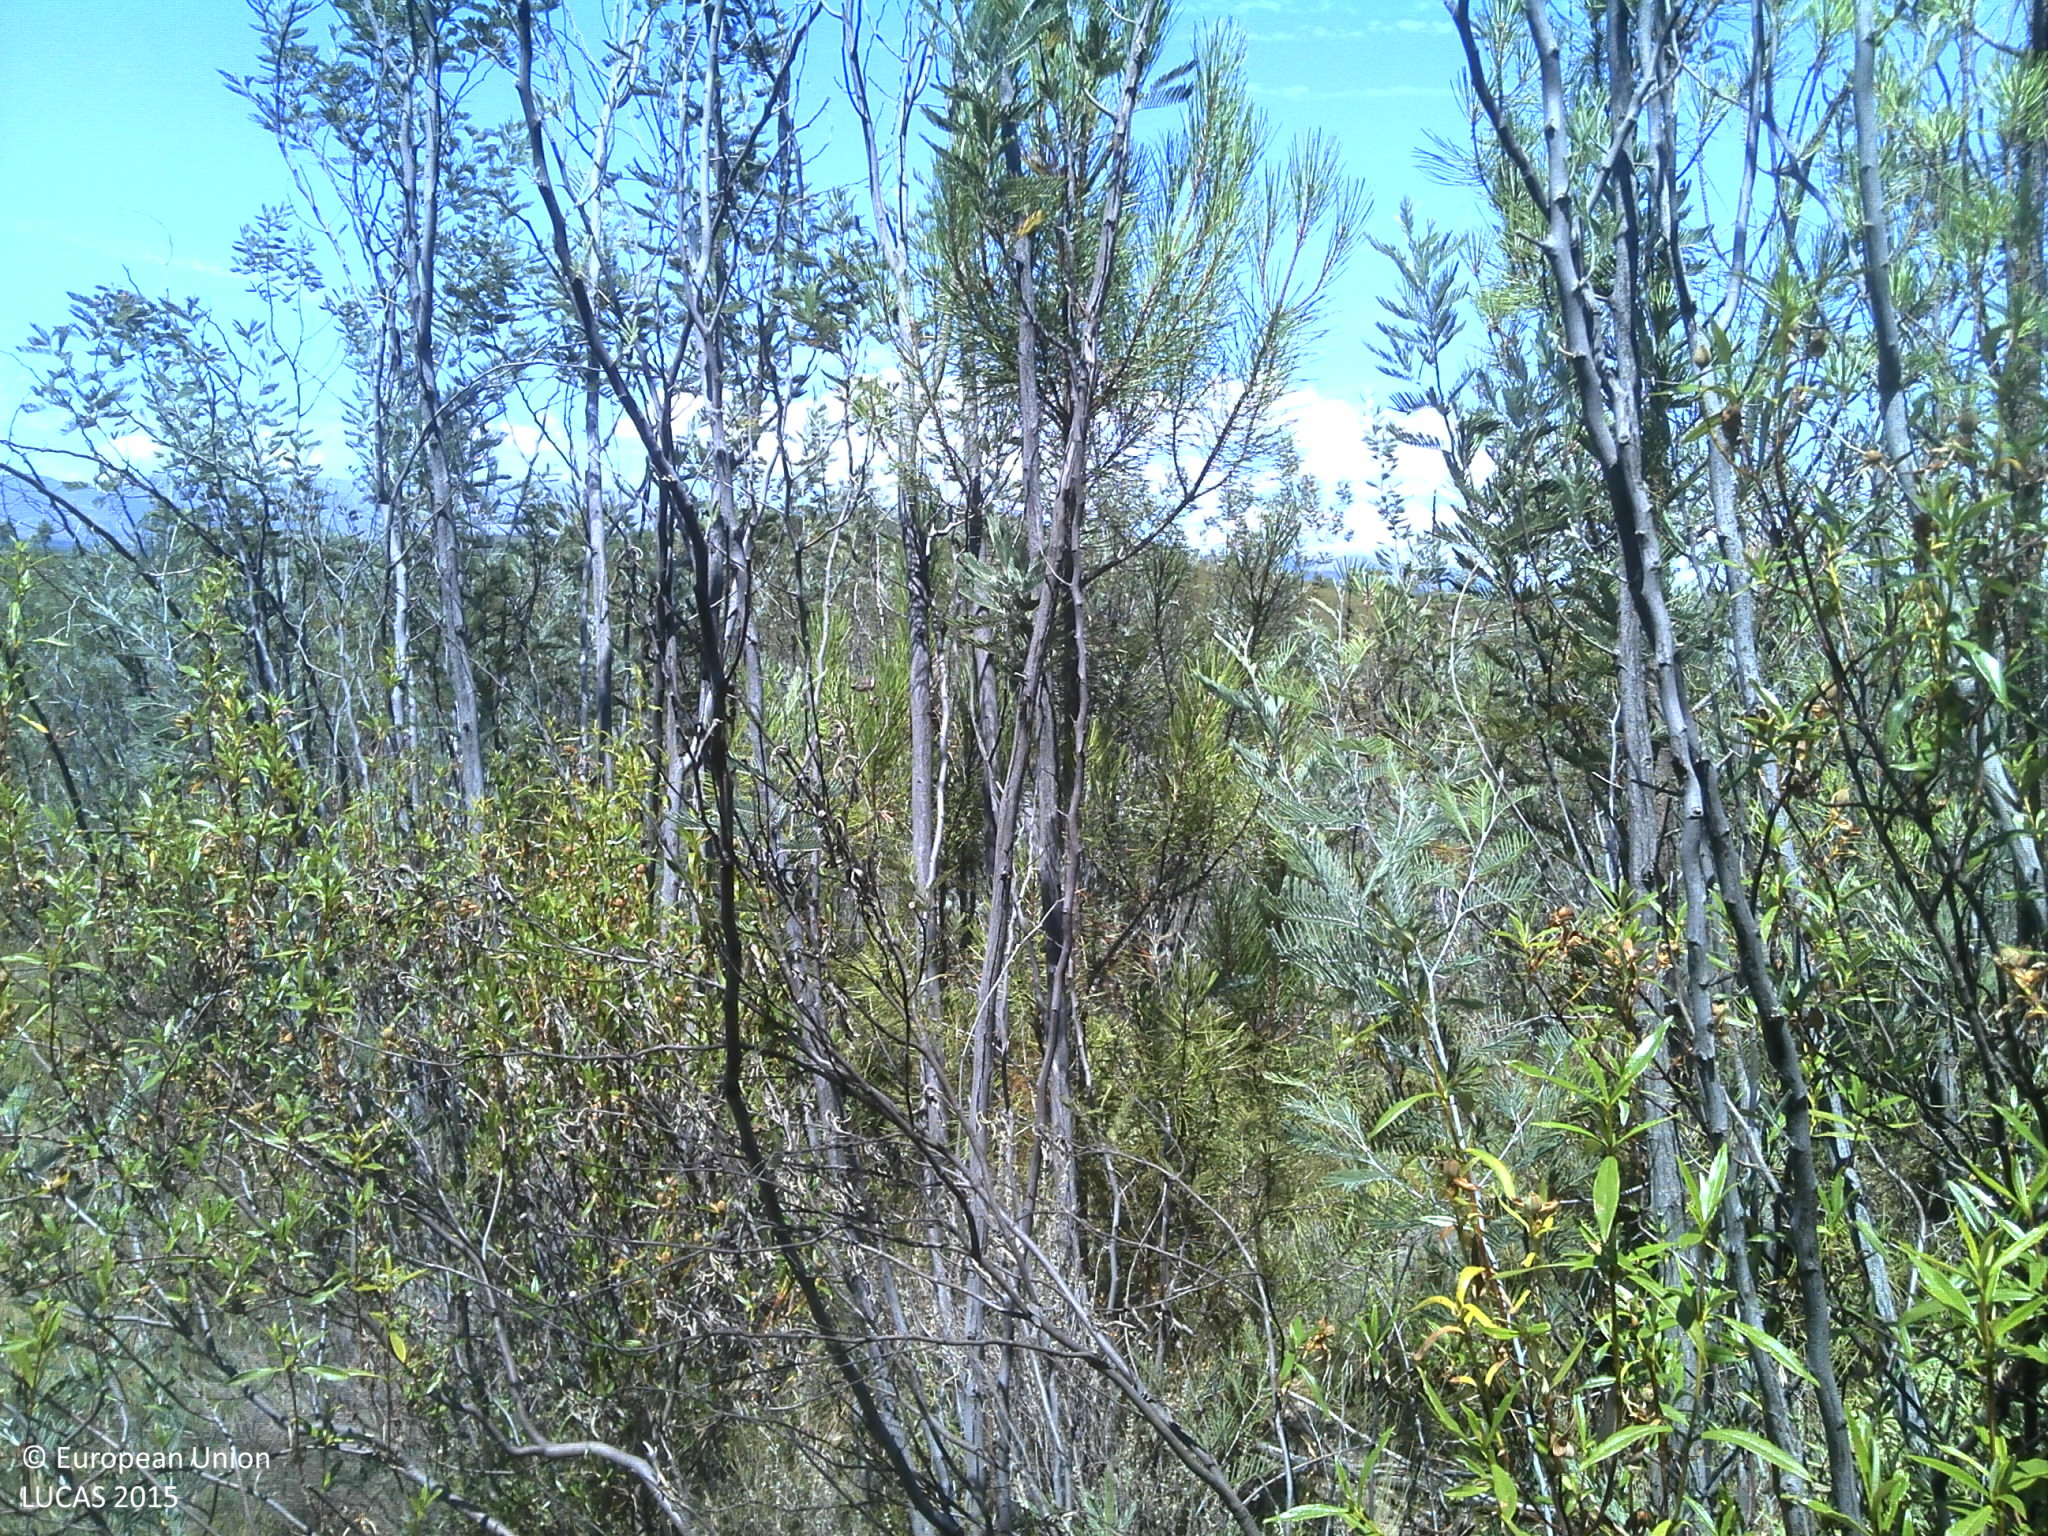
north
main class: Shrubland
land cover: Shrubland without tree cover
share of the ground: 50 - 75 %
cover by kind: shrubs 70 %, unconsolidated bare surface 20 %, herbaceous plants 10 %
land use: Abandoned areas
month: July
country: PT
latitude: 40.1470
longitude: -7.6579
